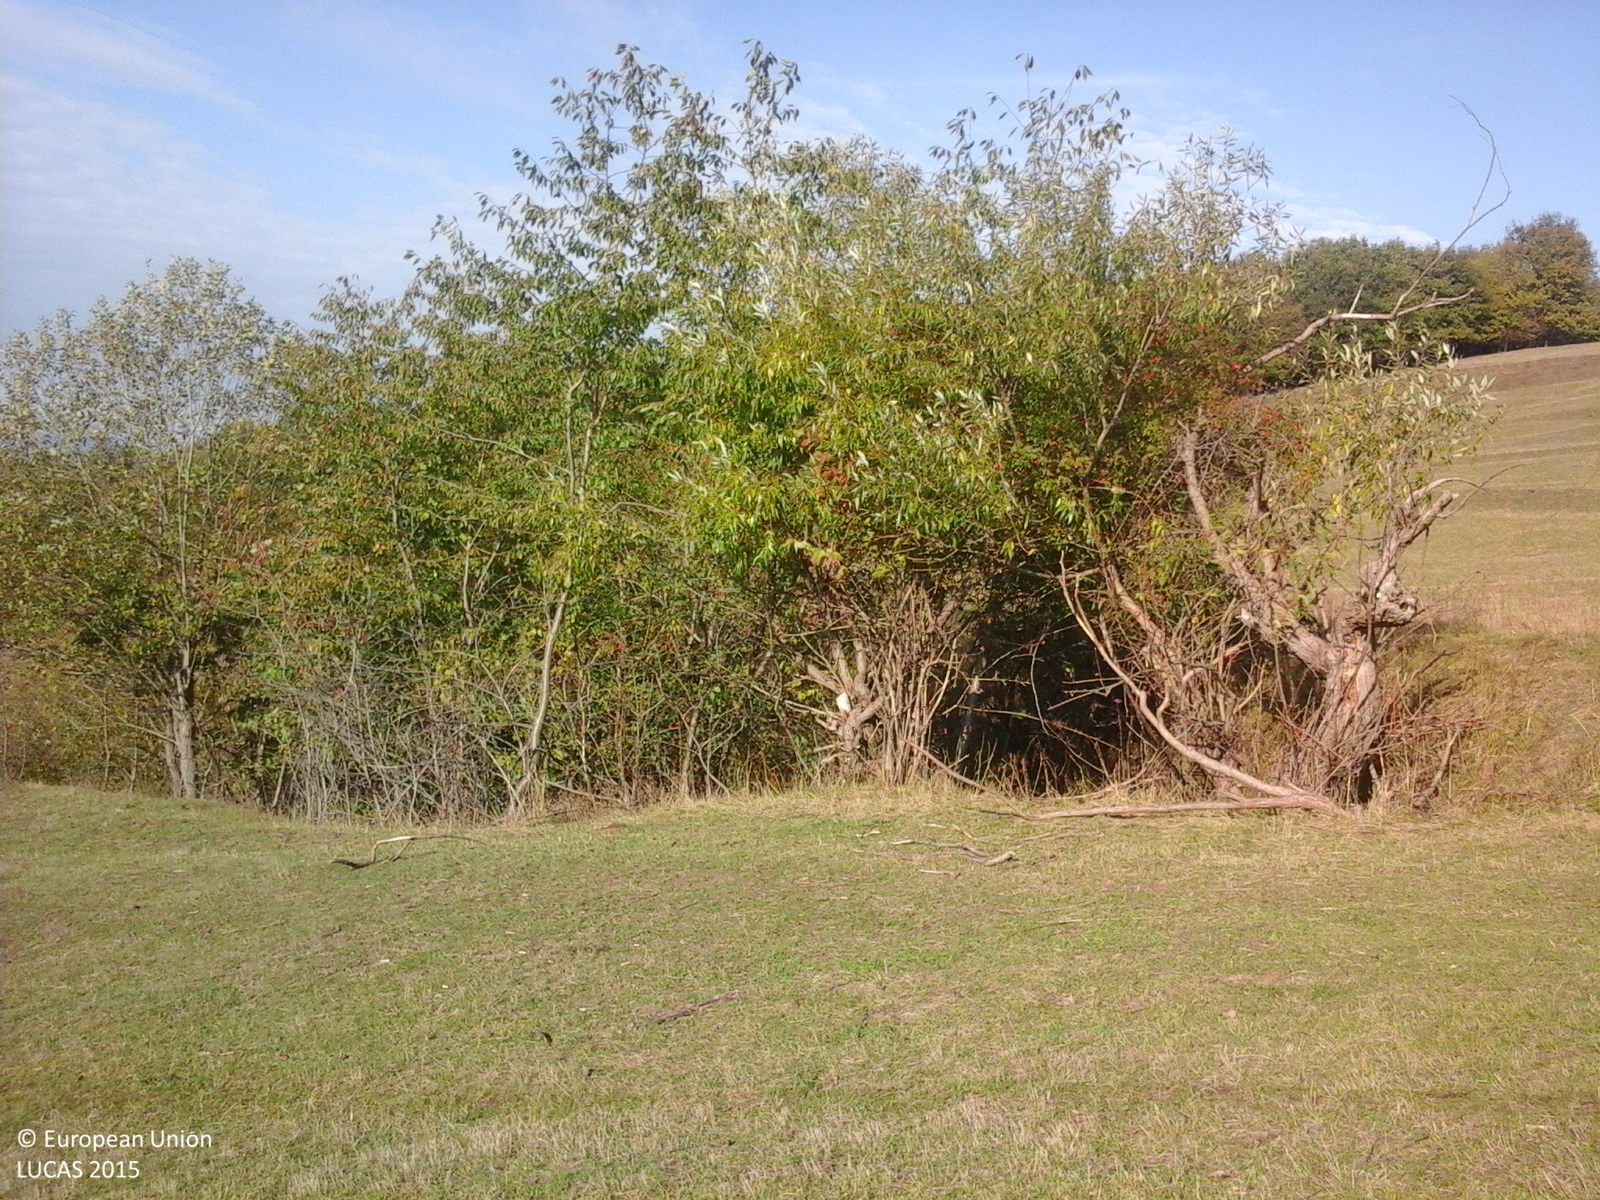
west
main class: Grassland
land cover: Grassland without tree/shrub cover
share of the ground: > 75 %
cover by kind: herbaceous plants 100 %
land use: Agriculture (excluding fallow land and kitchen gardens)
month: October
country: RO
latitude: 46.0637
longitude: 26.0584
